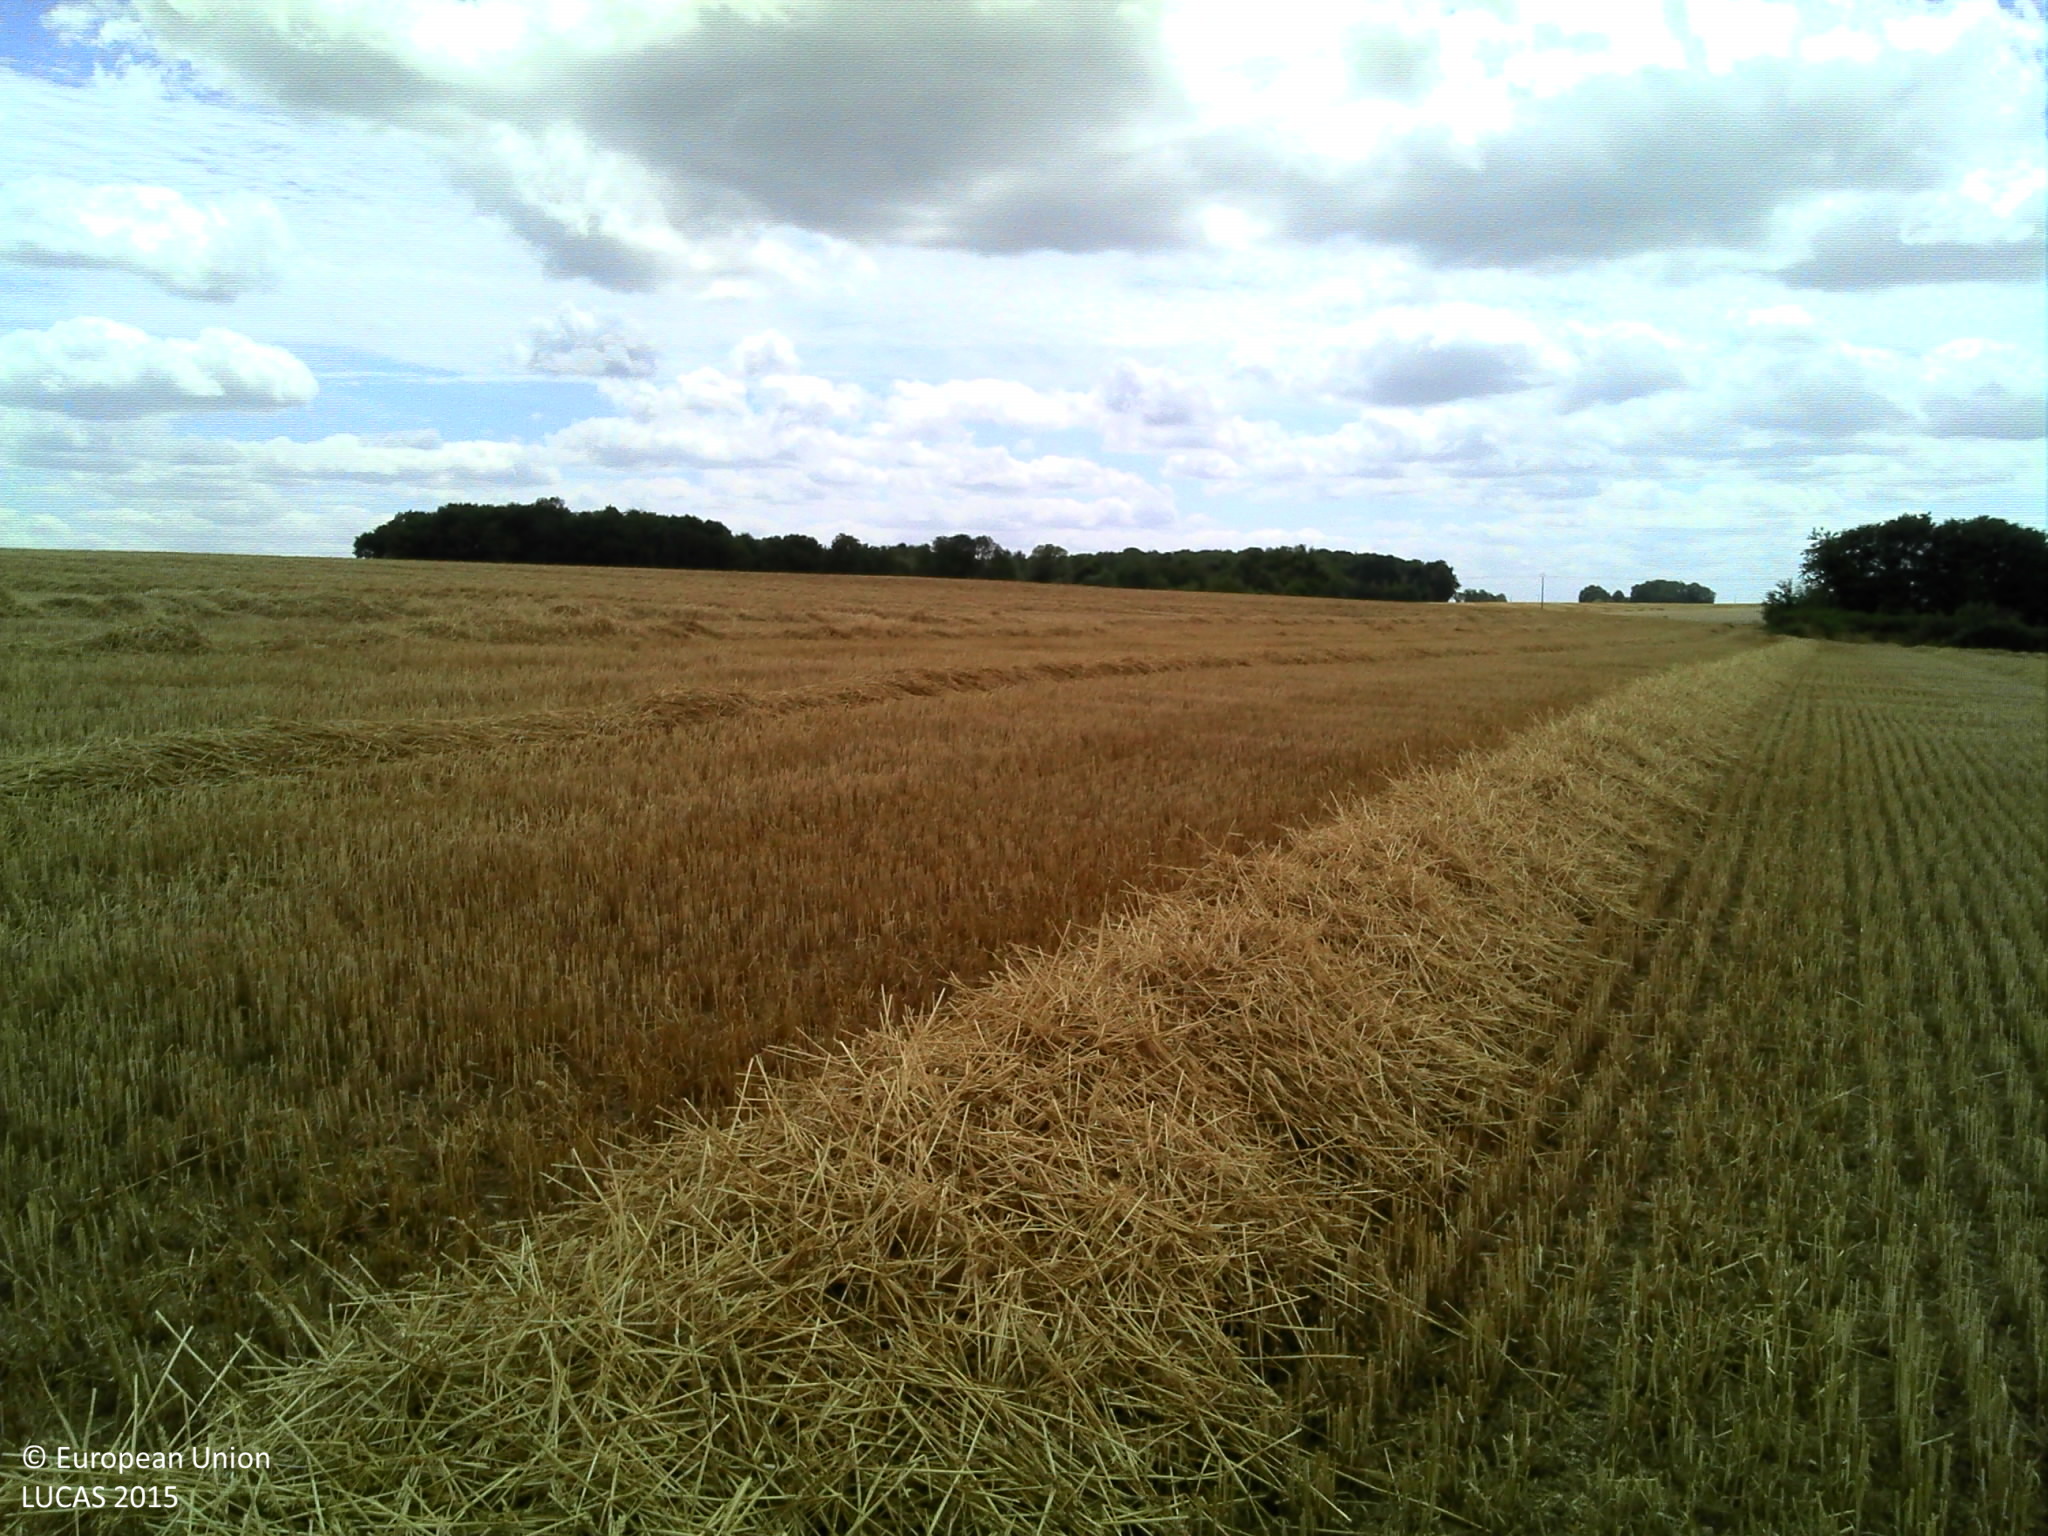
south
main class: Cropland
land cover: Common wheat
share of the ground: > 75 %
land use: Agriculture (excluding fallow land and kitchen gardens)
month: July
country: FR
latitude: 47.9009
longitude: 3.1313
